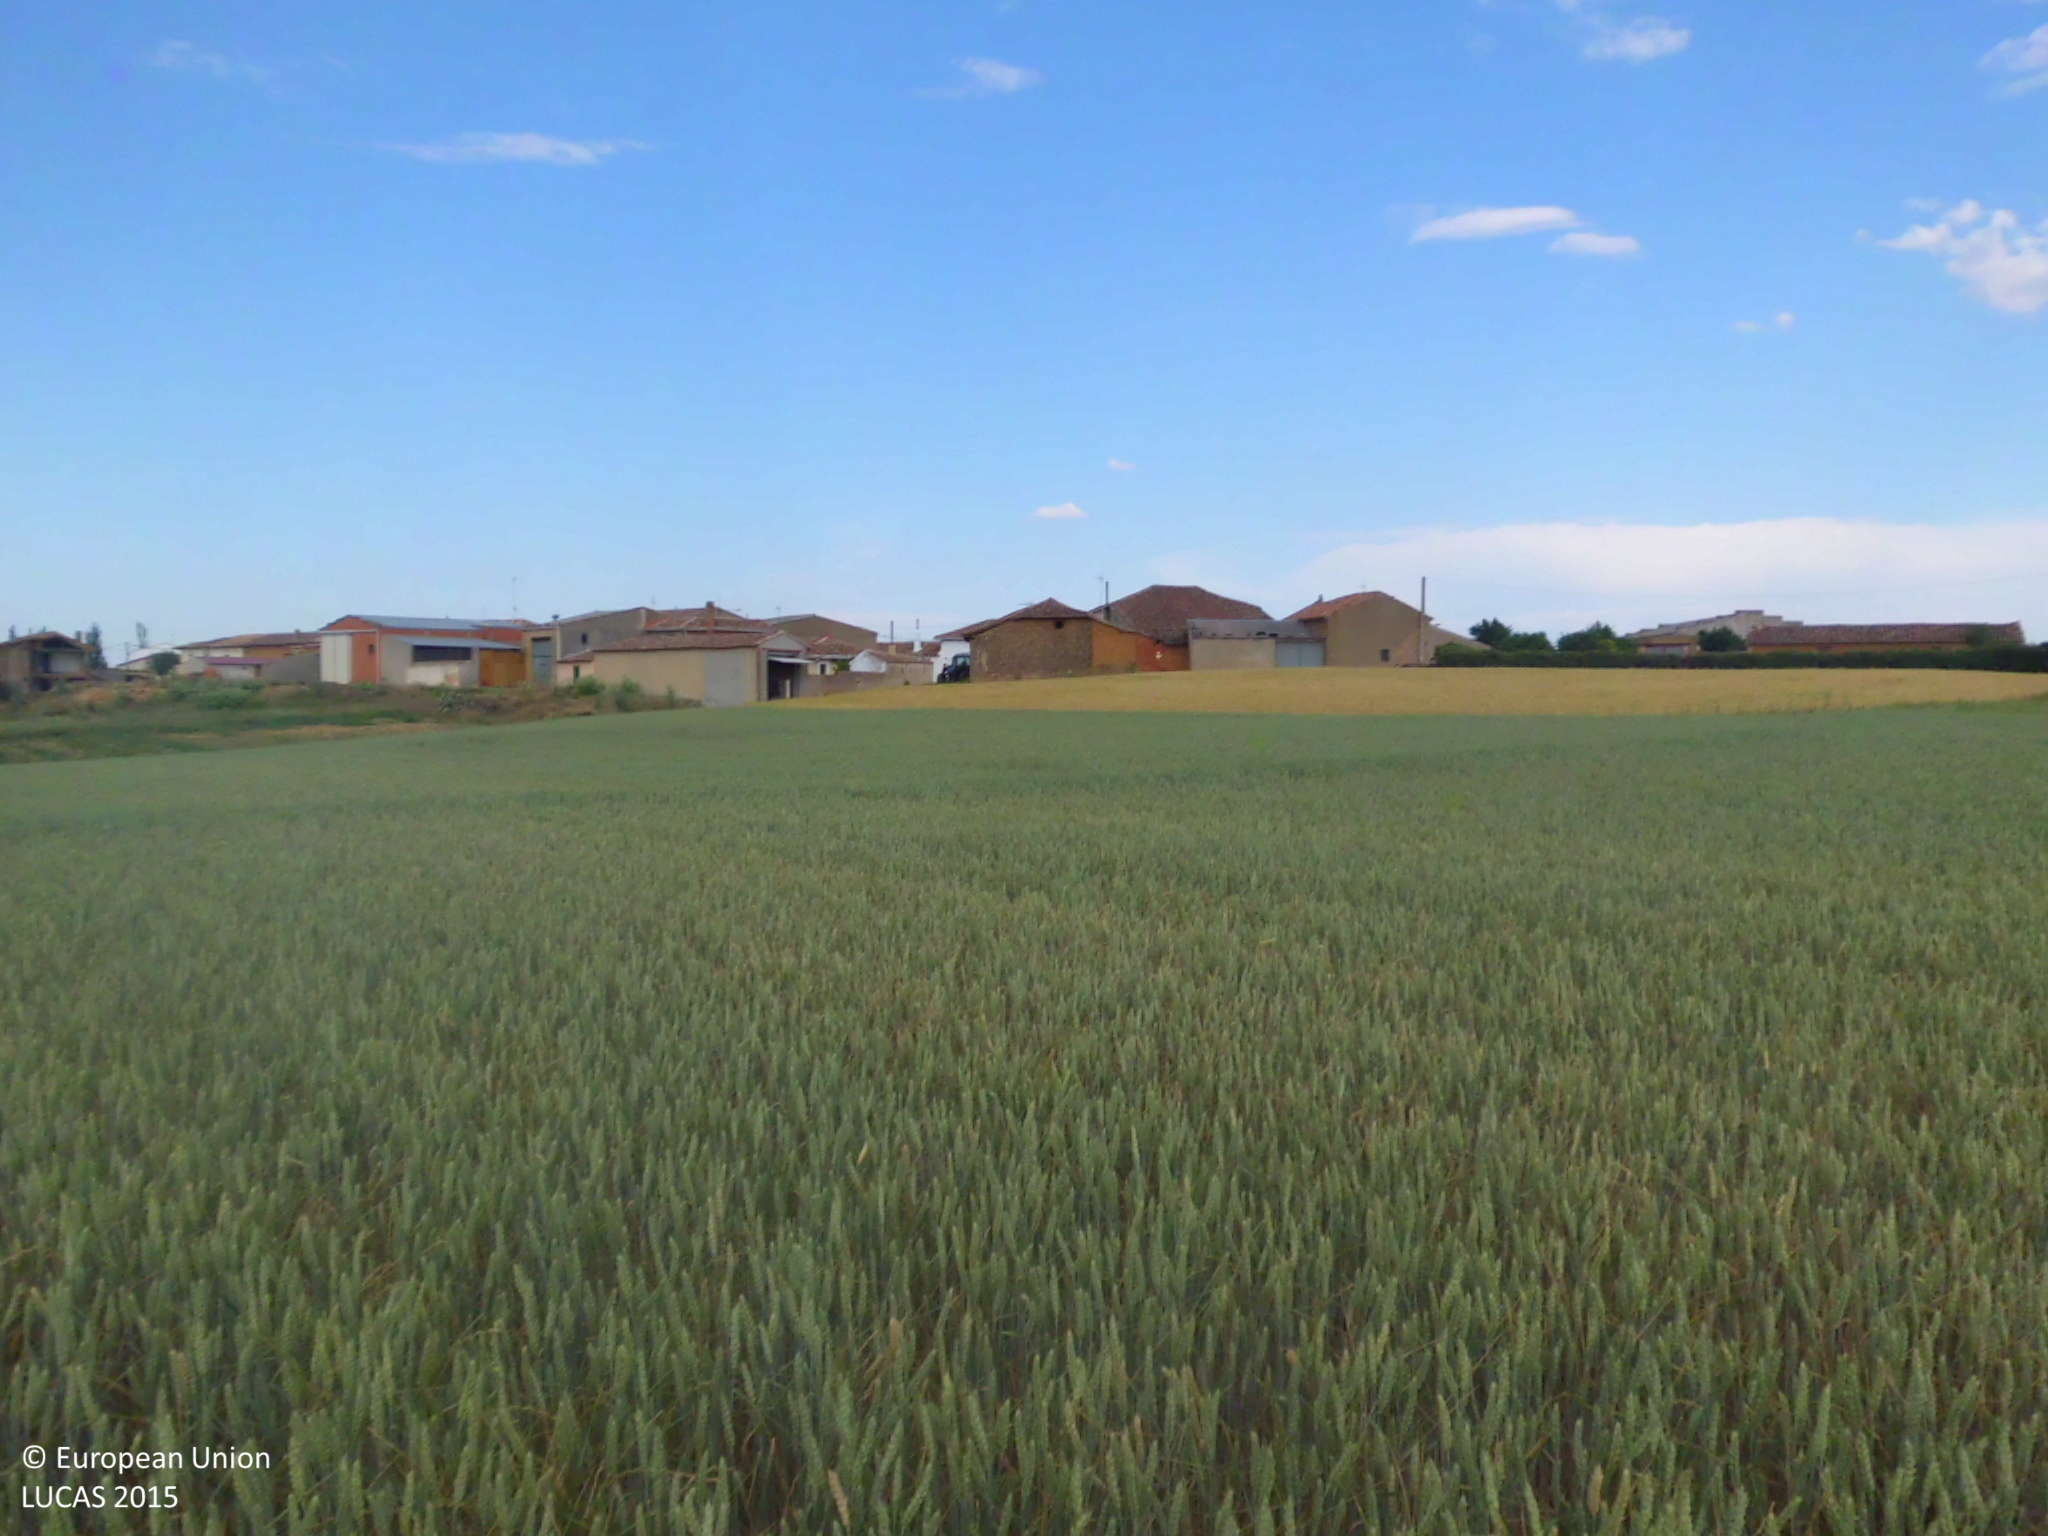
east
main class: Cropland
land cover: Common wheat
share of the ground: > 75 %
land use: Agriculture (excluding fallow land and kitchen gardens)
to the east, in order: Common wheat; Barley; Artificial constructions in urban areas
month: June
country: ES
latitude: 42.5163
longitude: -4.3999
